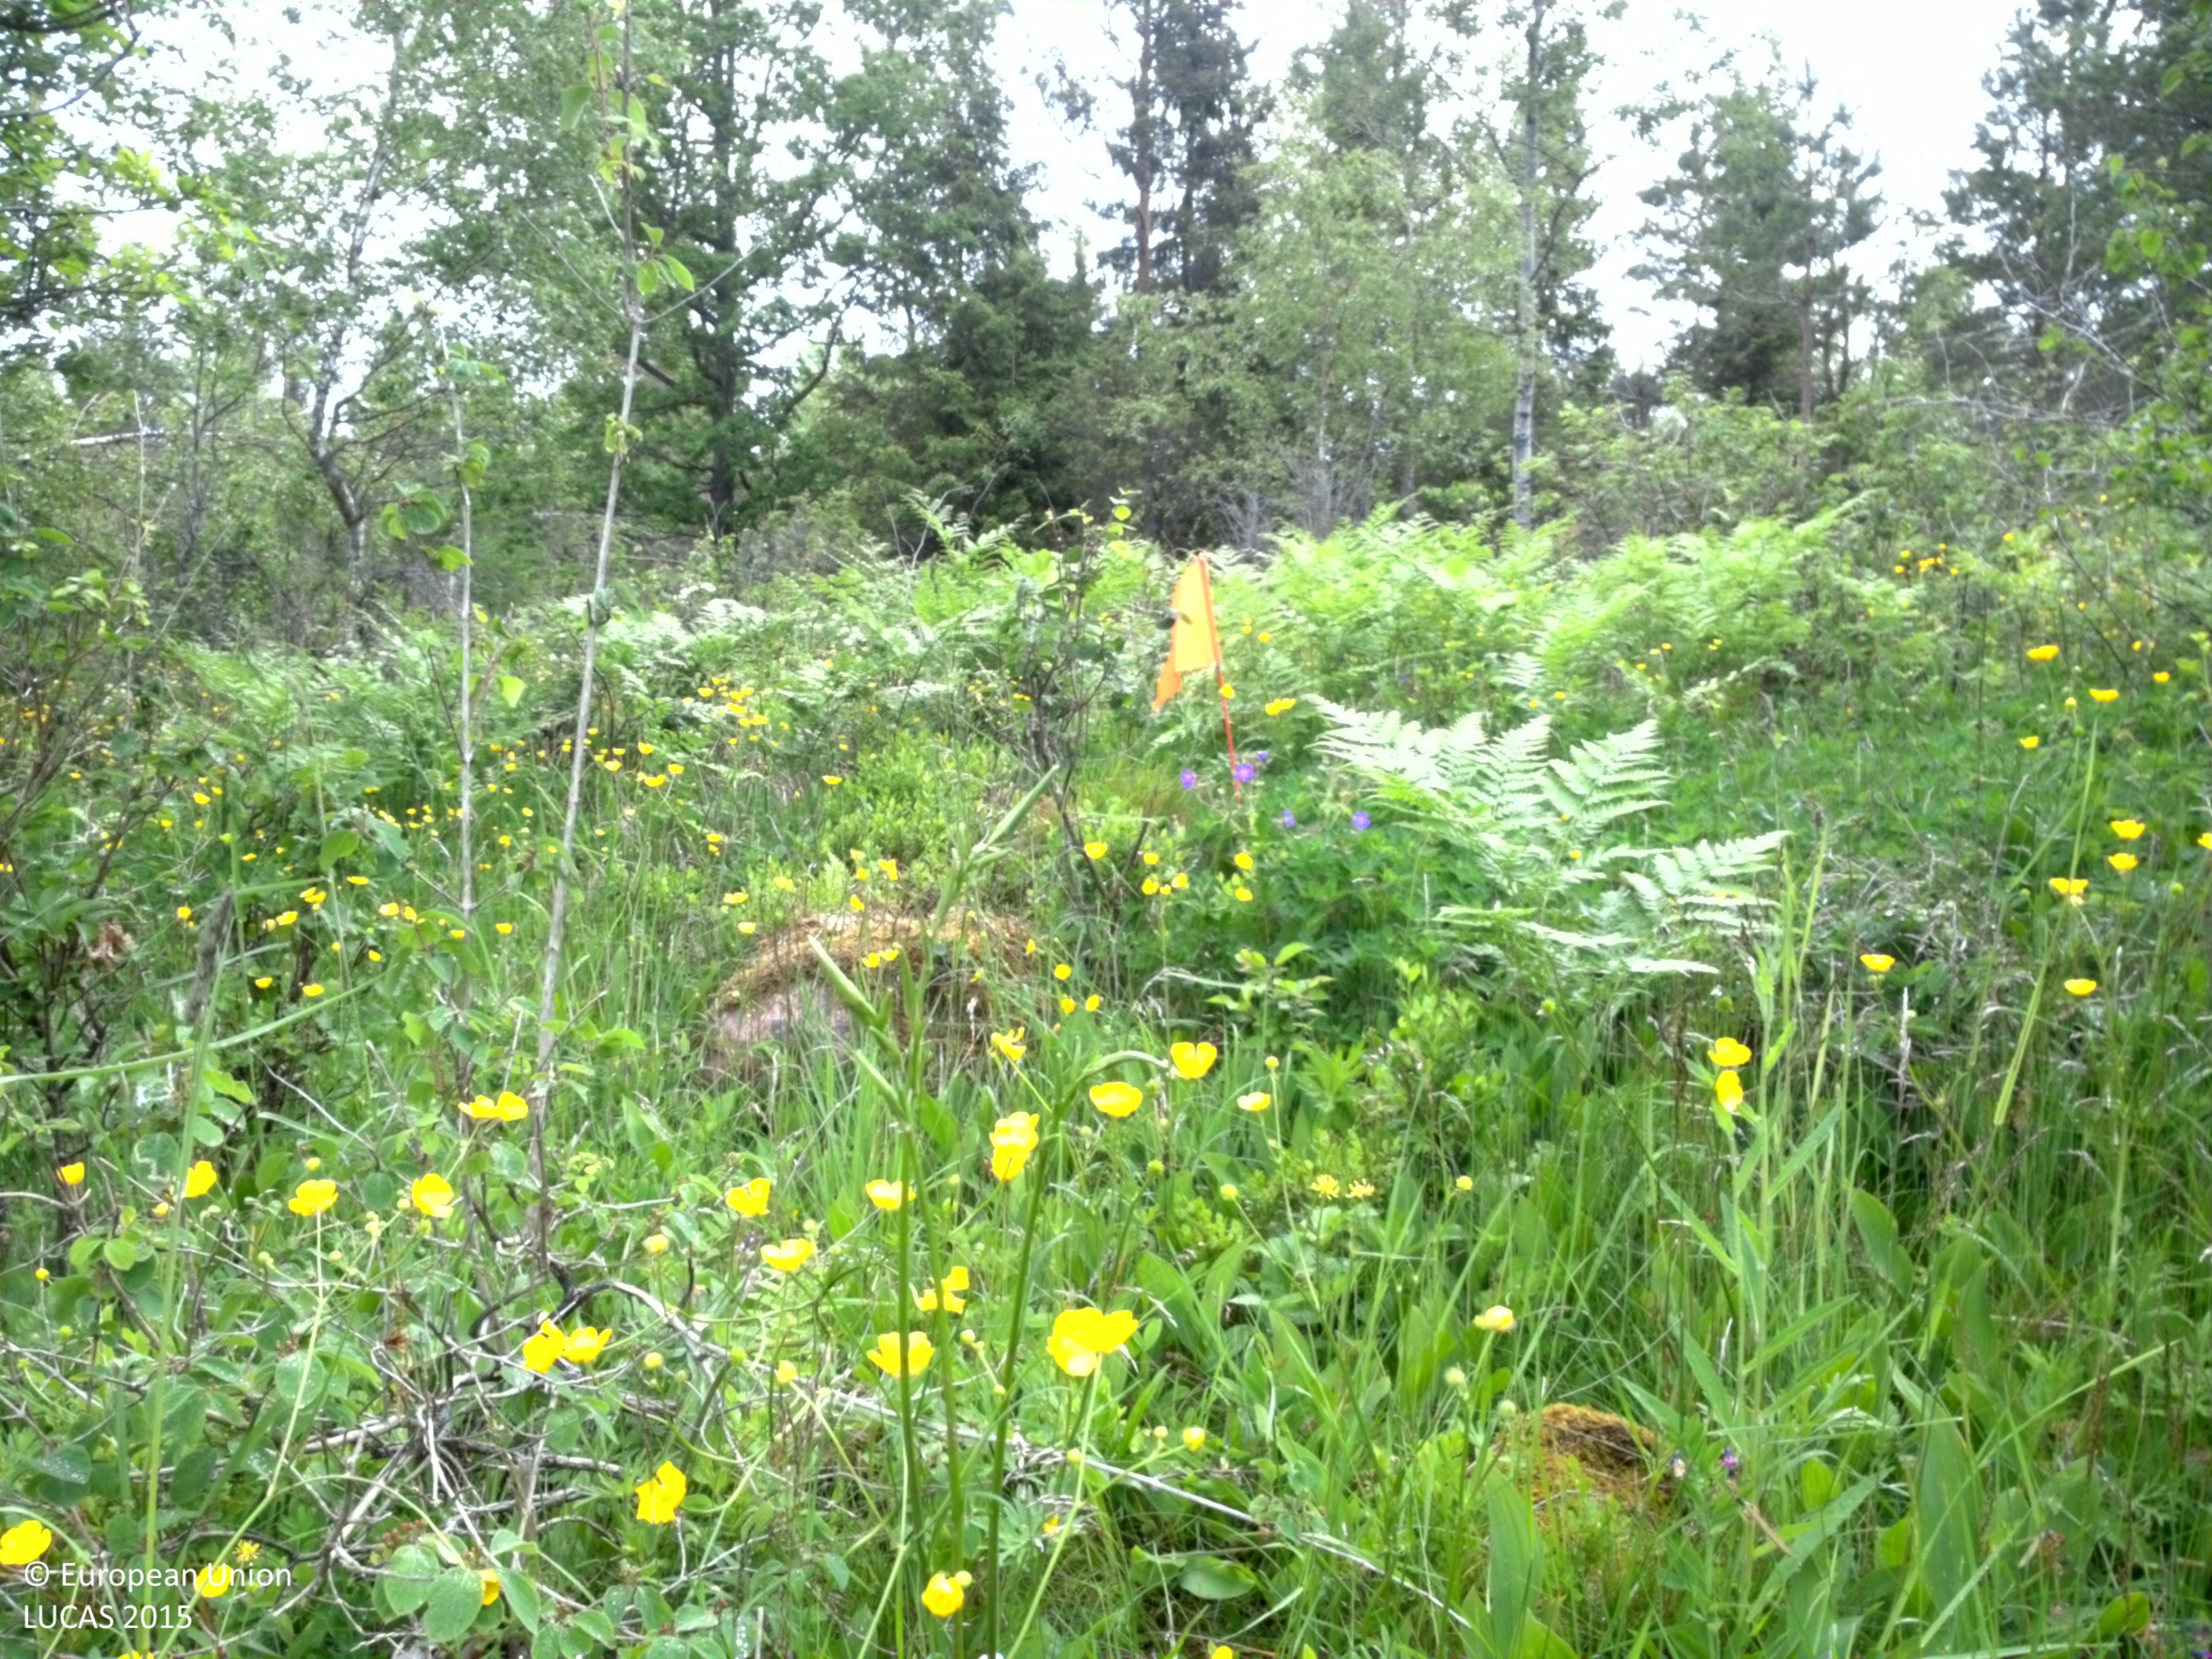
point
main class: Woodland
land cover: Broadleaved woodland
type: hemiboreal forest and nemoral coniferous forest and mixed broadleaved-coniferous forest
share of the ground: 10 - 25 %
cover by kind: herbaceous plants 50 %, broadleaved forest trees 20 %, lichens and mosses 15 %, shrubs 10 %, coniferous forest trees 5 %
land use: Forestry
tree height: > 5 m
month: June
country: SE
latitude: 60.0159
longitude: 18.7711
